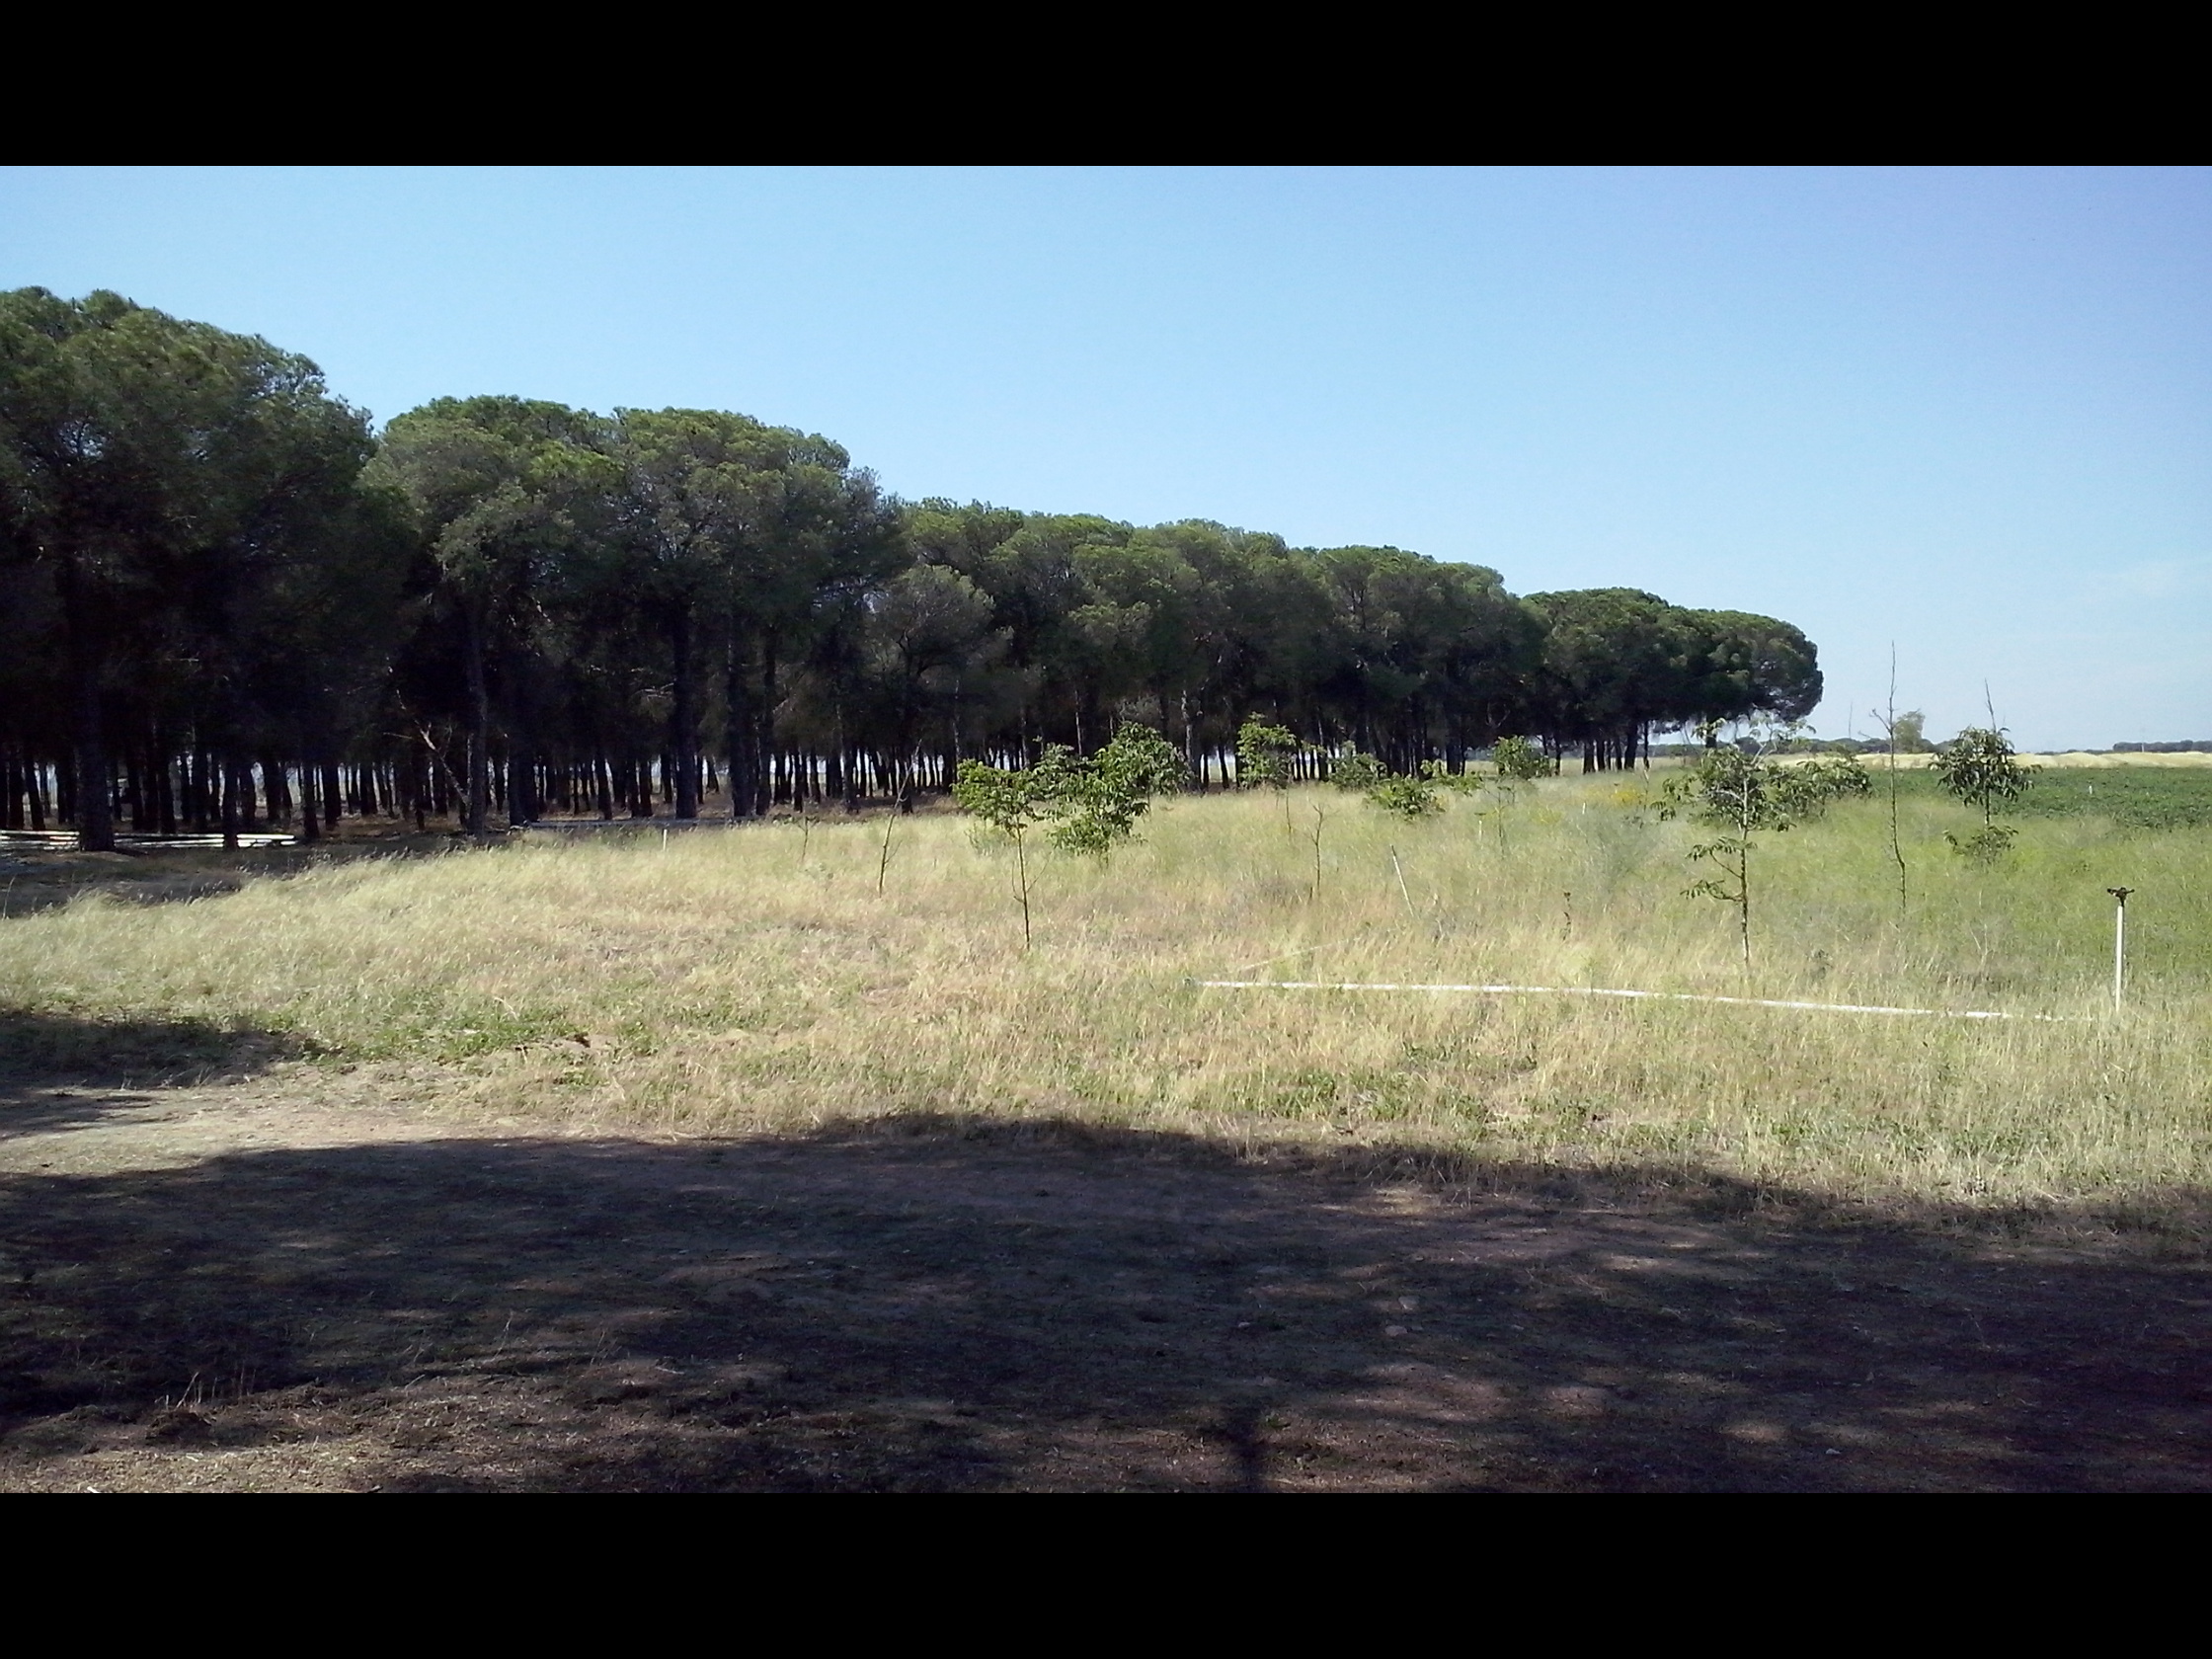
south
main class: Woodland
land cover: Pine dominated coniferous woodland
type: coniferous forest of the mediterranean region
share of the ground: 50 - 75 %
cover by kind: coniferous forest trees 60 %, herbaceous plants 25 %, unconsolidated bare surface 15 %
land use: Forestry
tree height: > 5 m
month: July
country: ES
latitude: 41.5163
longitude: -5.0879
